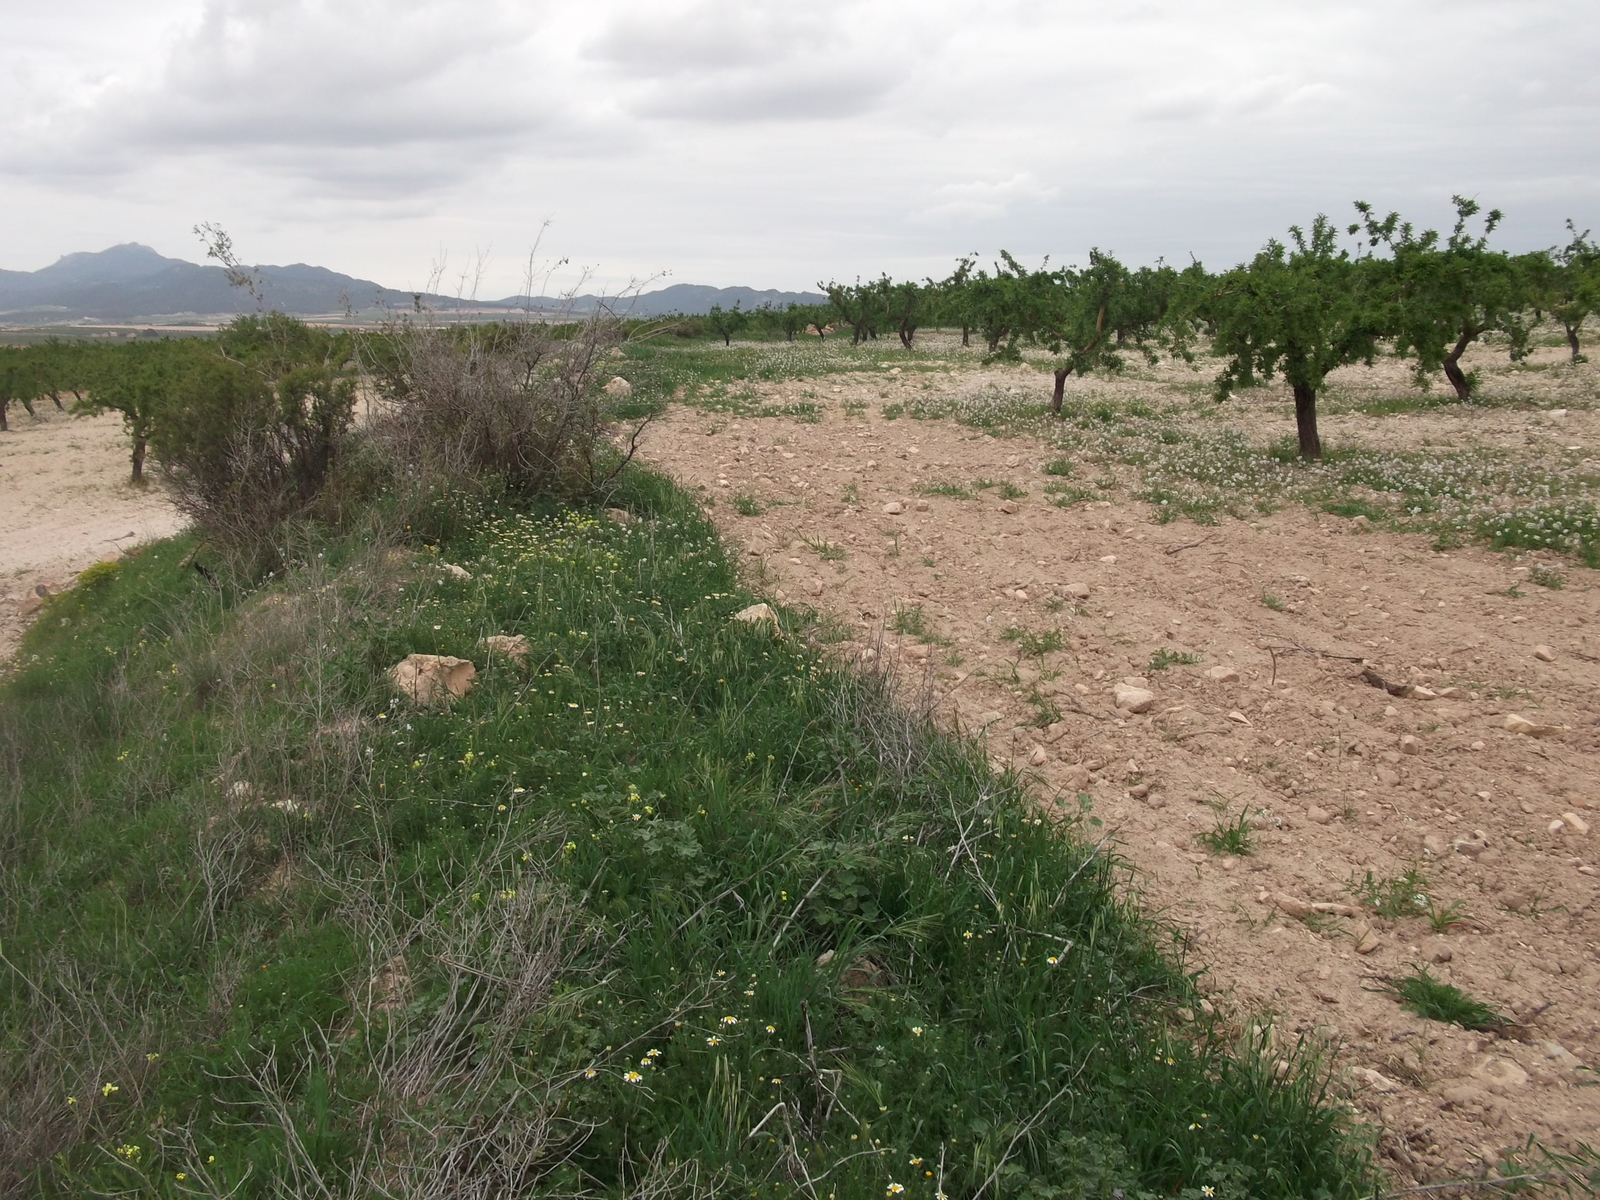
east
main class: Shrubland
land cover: Shrubland without tree cover
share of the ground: 25 - 50 %
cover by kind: shrubs 50 %, herbaceous plants 50 %
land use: Abandoned areas
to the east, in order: Shrubland without tree cover; Nuts trees; Grass margins; Nuts trees
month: April
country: ES
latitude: 38.0983
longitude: -1.5846
